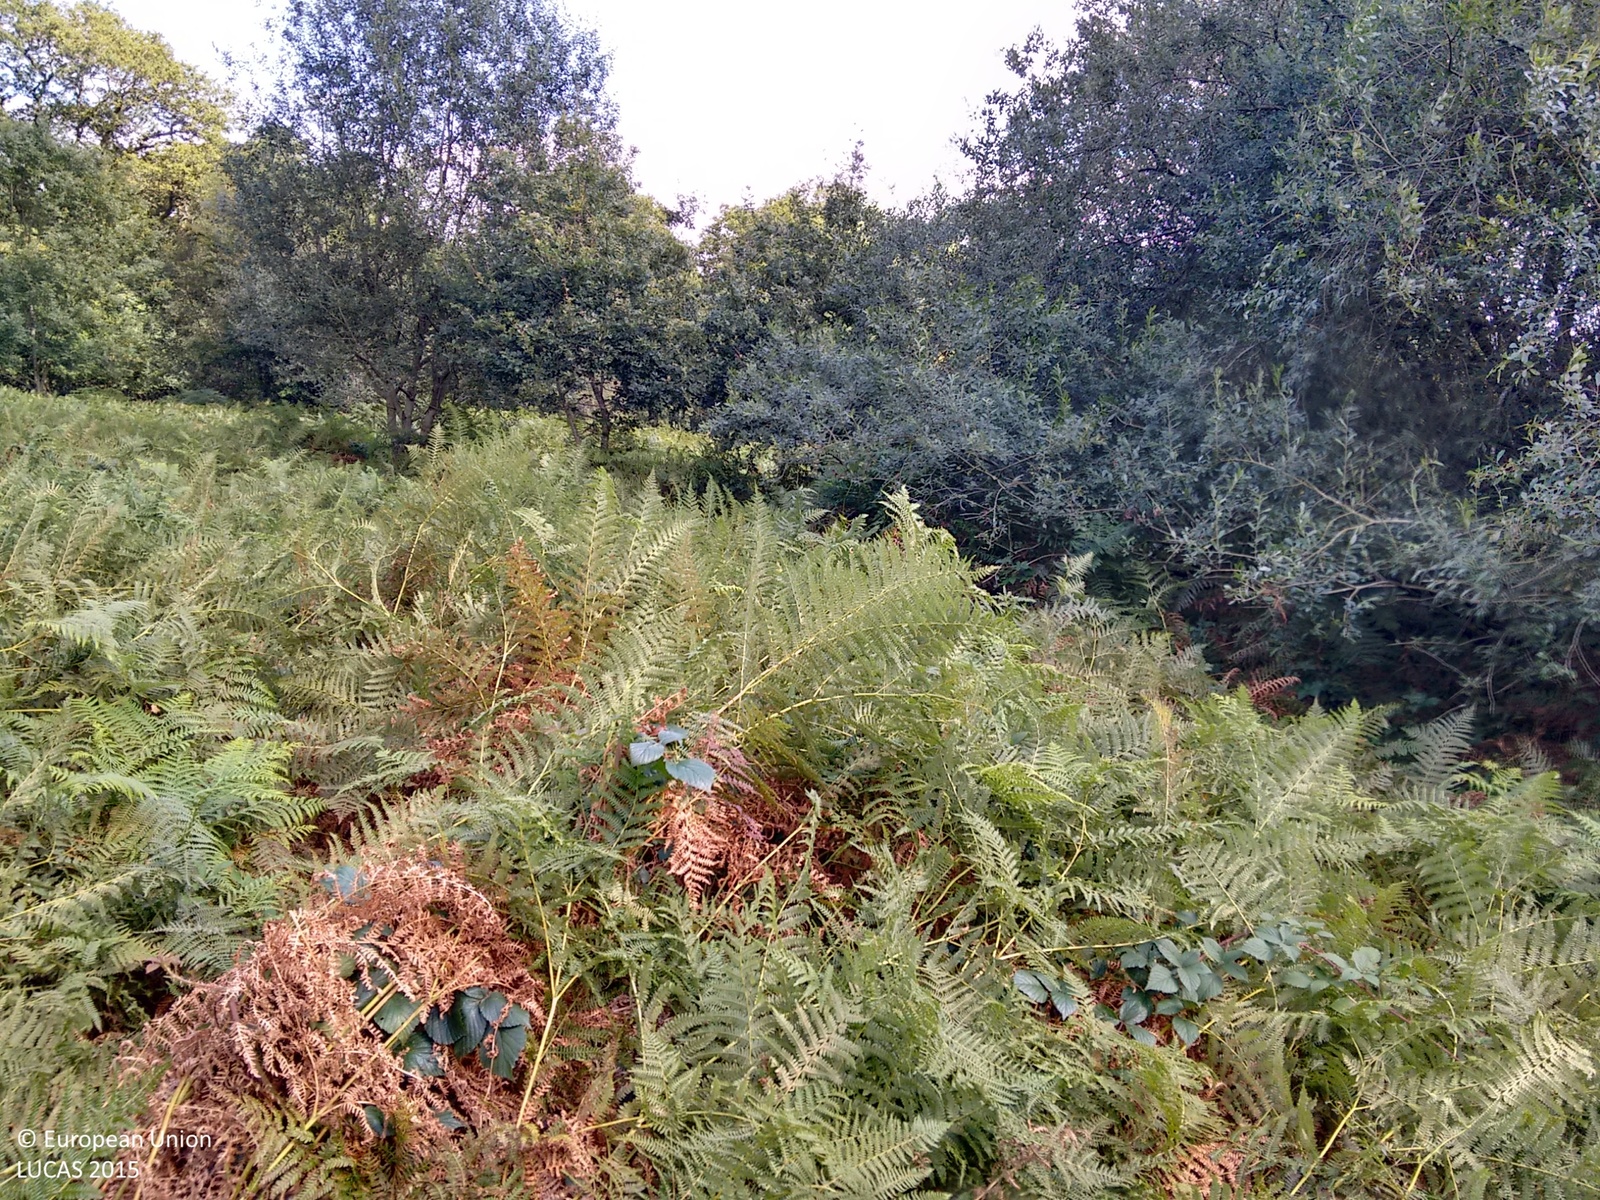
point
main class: Woodland
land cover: Broadleaved woodland
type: mesophytic deciduous forest
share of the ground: > 75 %
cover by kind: herbaceous plants 80 %, broadleaved forest trees 20 %
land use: Agriculture (excluding fallow land and kitchen gardens)
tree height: < 5 m
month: September
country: GB
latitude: 52.1504
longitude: -3.4861
